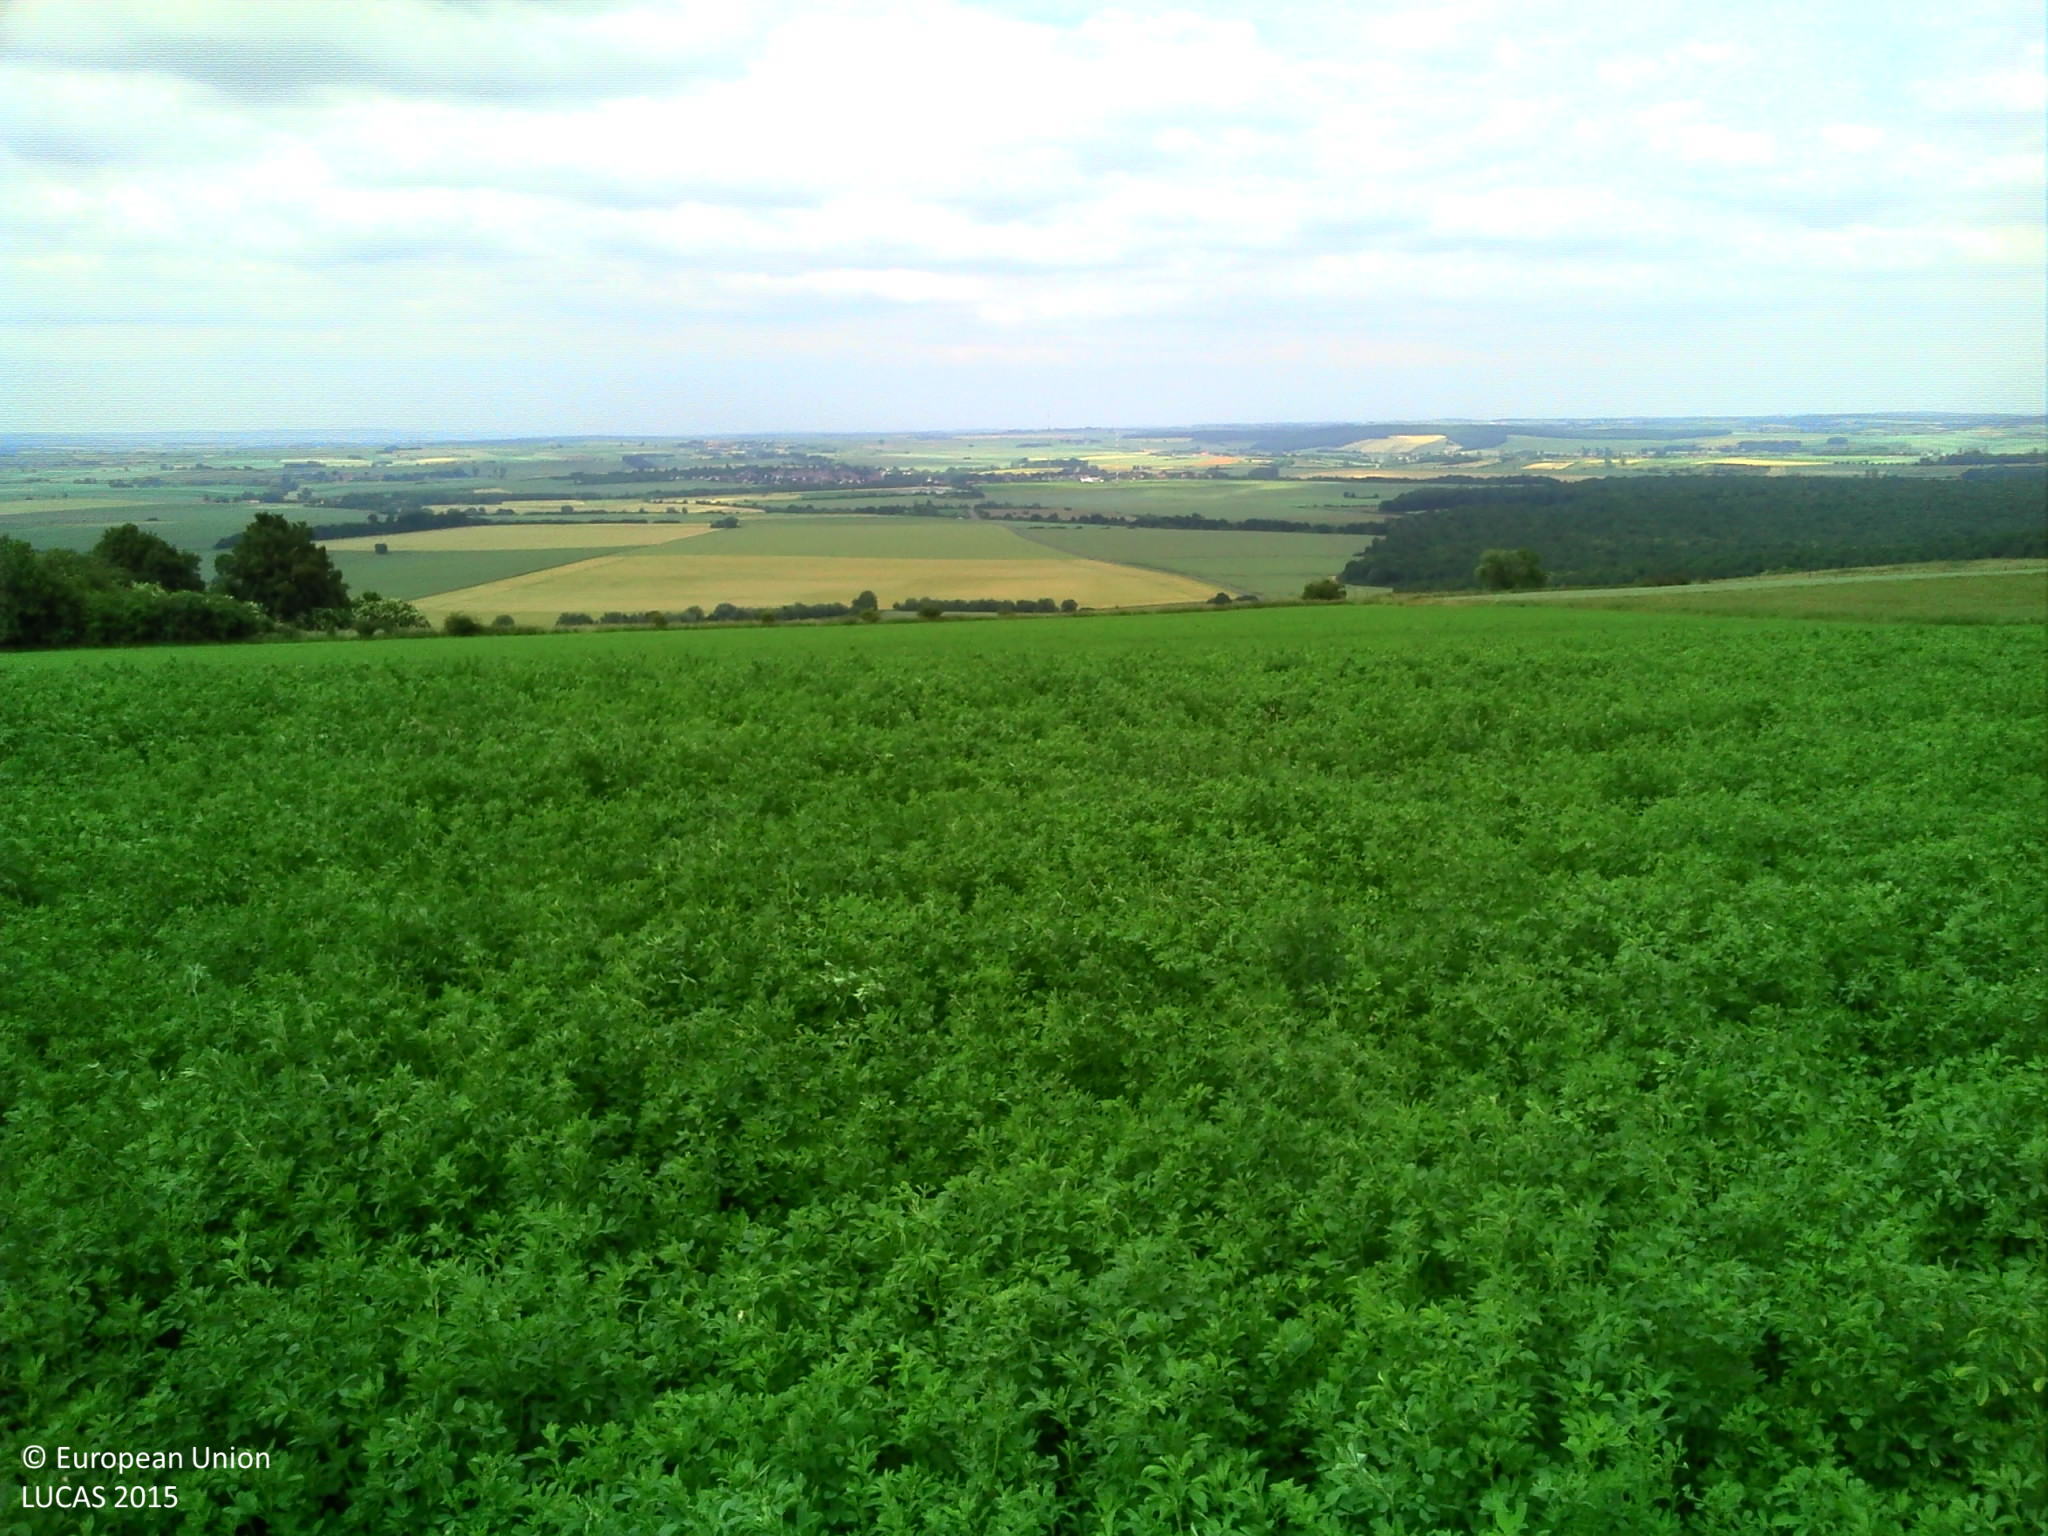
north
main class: Cropland
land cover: Lucerne
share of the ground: > 75 %
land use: Agriculture (excluding fallow land and kitchen gardens)
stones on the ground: 25 - 50 %
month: June
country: FR
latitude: 48.8434
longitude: 6.2255
